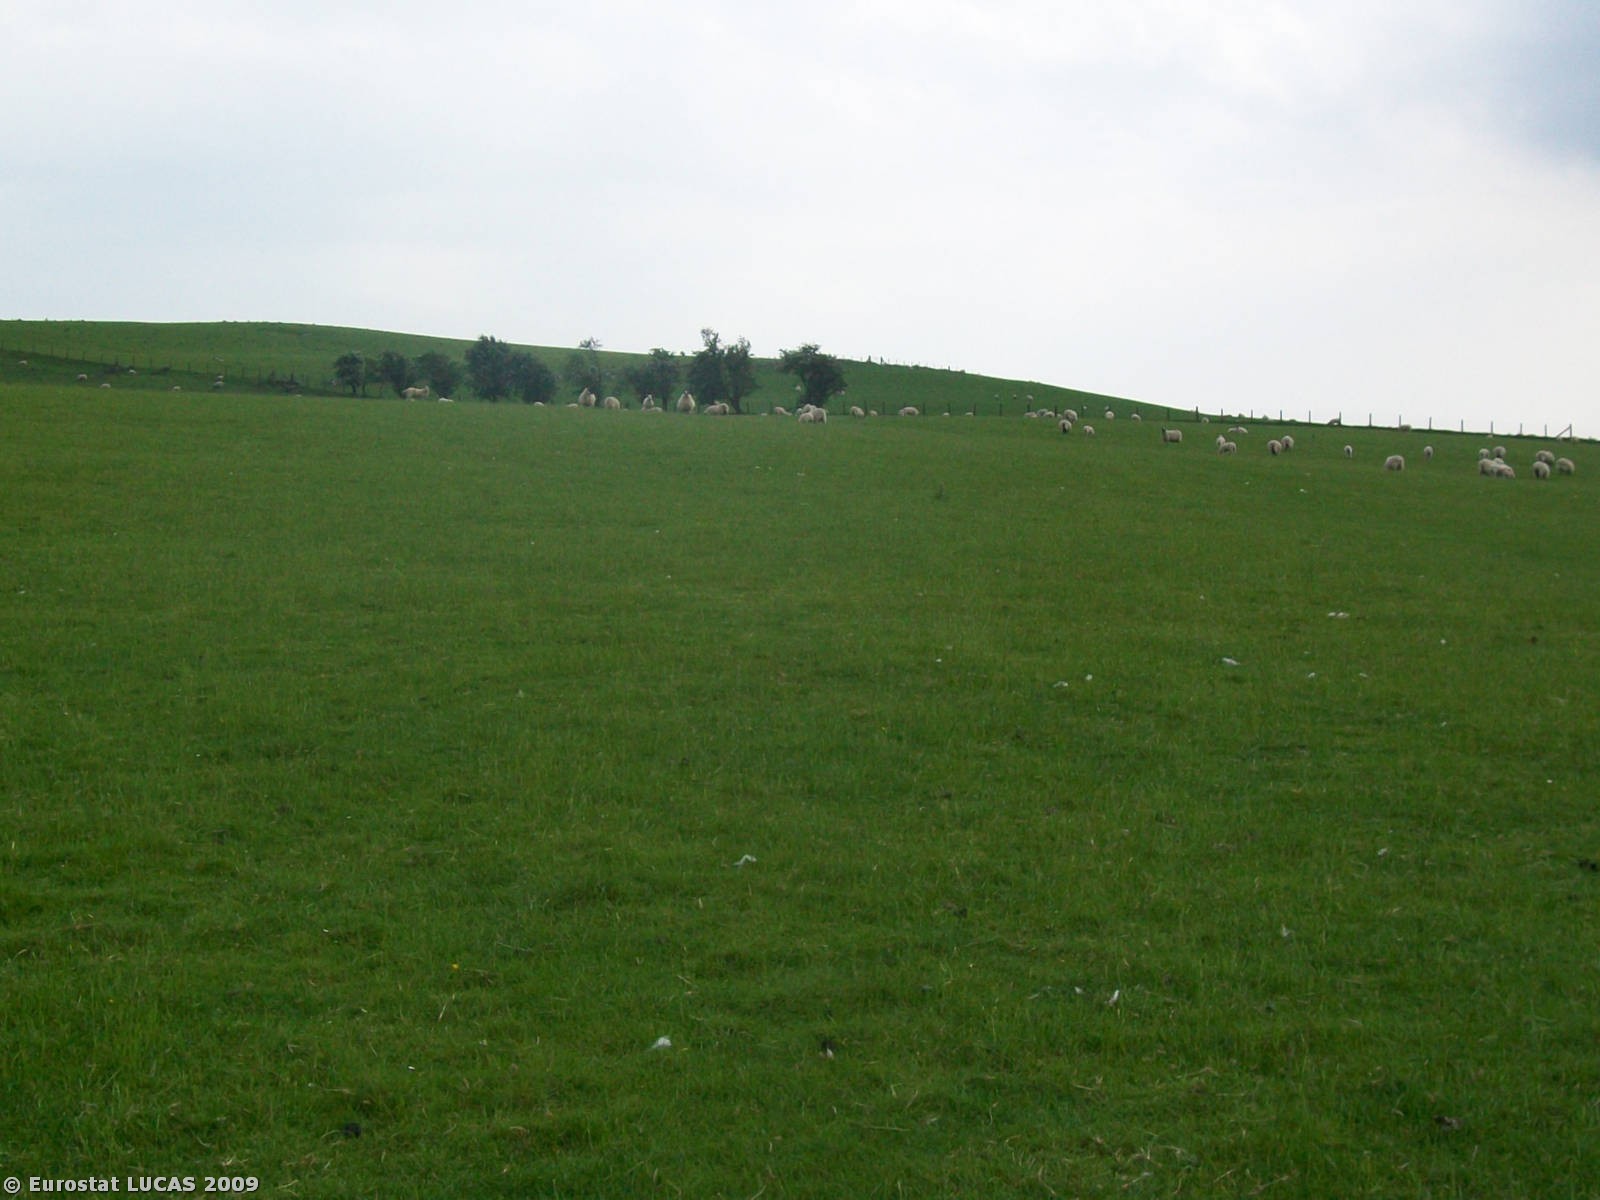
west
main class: Grassland
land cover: Grassland without tree/shrub cover
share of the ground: > 75 %
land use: Agriculture (excluding fallow land and kitchen gardens)
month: June
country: GB
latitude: 52.1688
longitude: -3.1639
